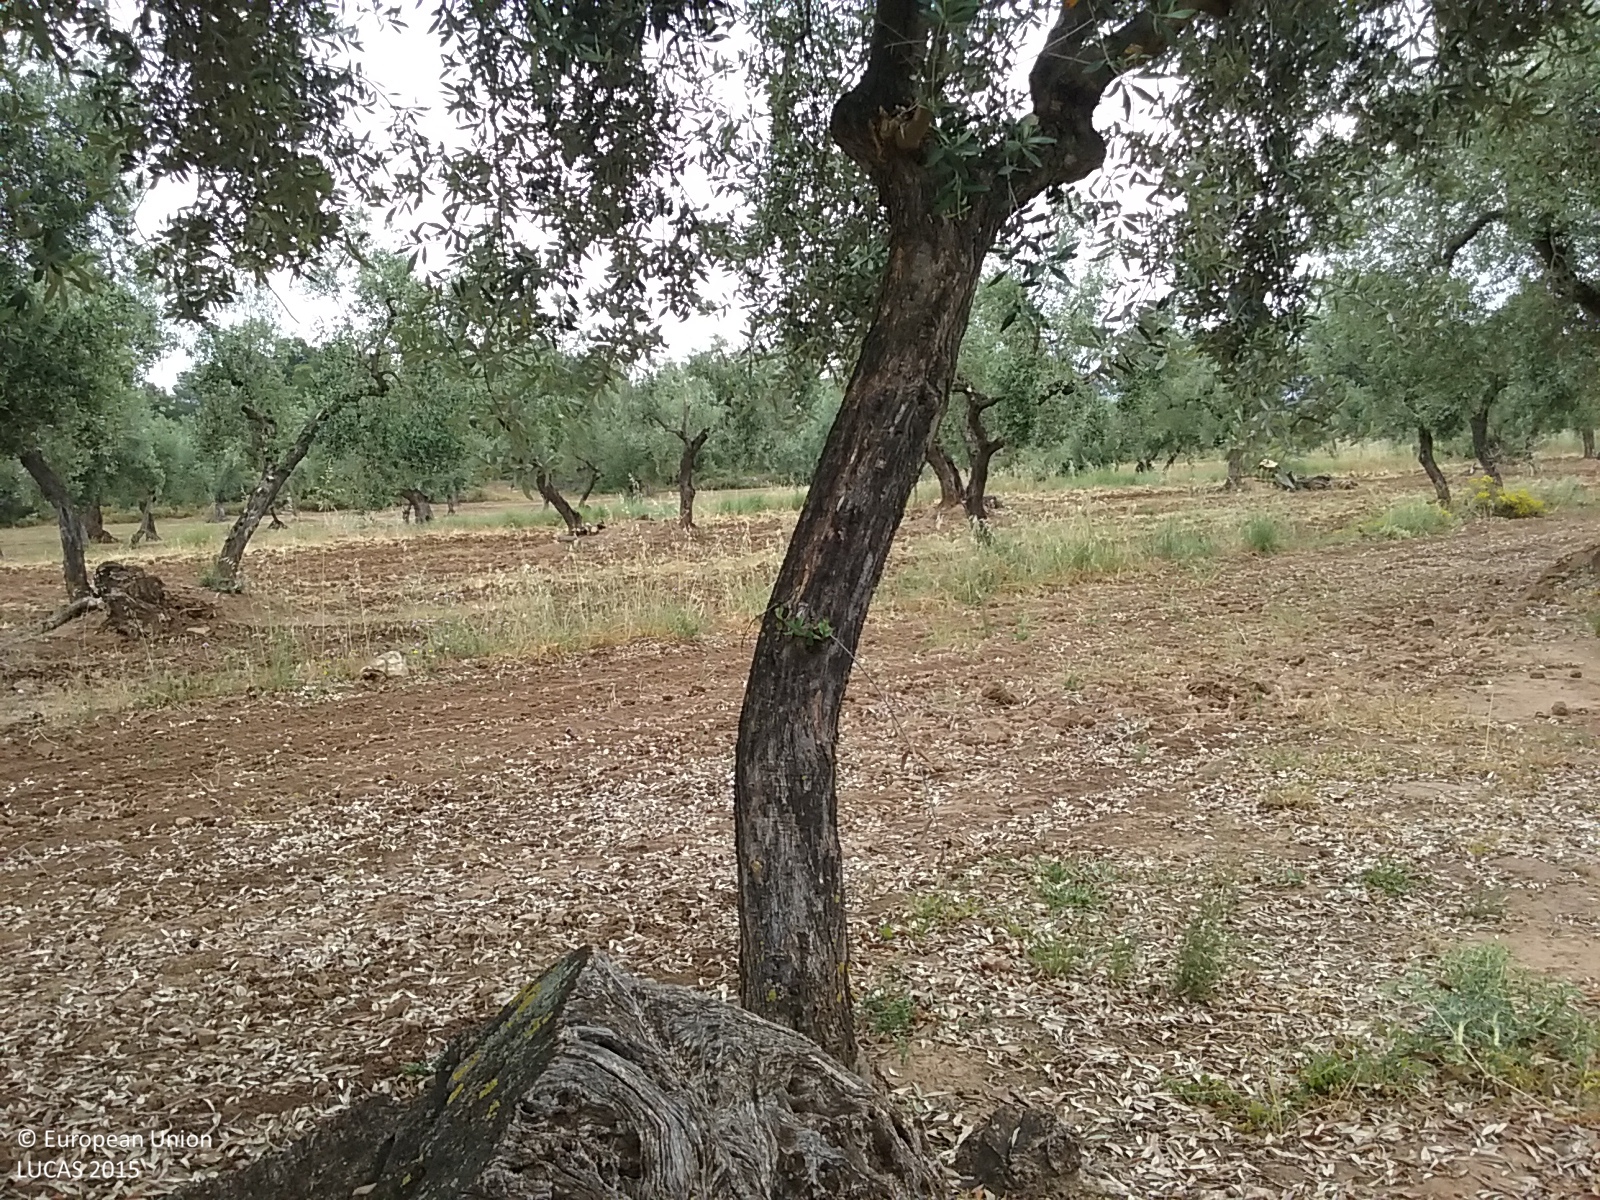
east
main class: Cropland
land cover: Olive groves
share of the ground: 25 - 50 %
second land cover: Spontaneously vegetated surfaces
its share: < 10 %
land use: Agriculture (excluding fallow land and kitchen gardens)
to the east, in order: Olive groves; Spontaneously vegetated surfaces; Grass margins; Olive groves; Grass margins; Olive groves; Broadleaved woodland; Artificial constructions in urban areas; Tracks; Pine dominated coniferous woodland; Dry stone walls; Pine dominated coniferous woodland; Olive groves; Dry stone walls; Olive groves; Dry stone walls; Pine dominated coniferous woodland
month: June
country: ES
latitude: 40.9221
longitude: 0.1950
